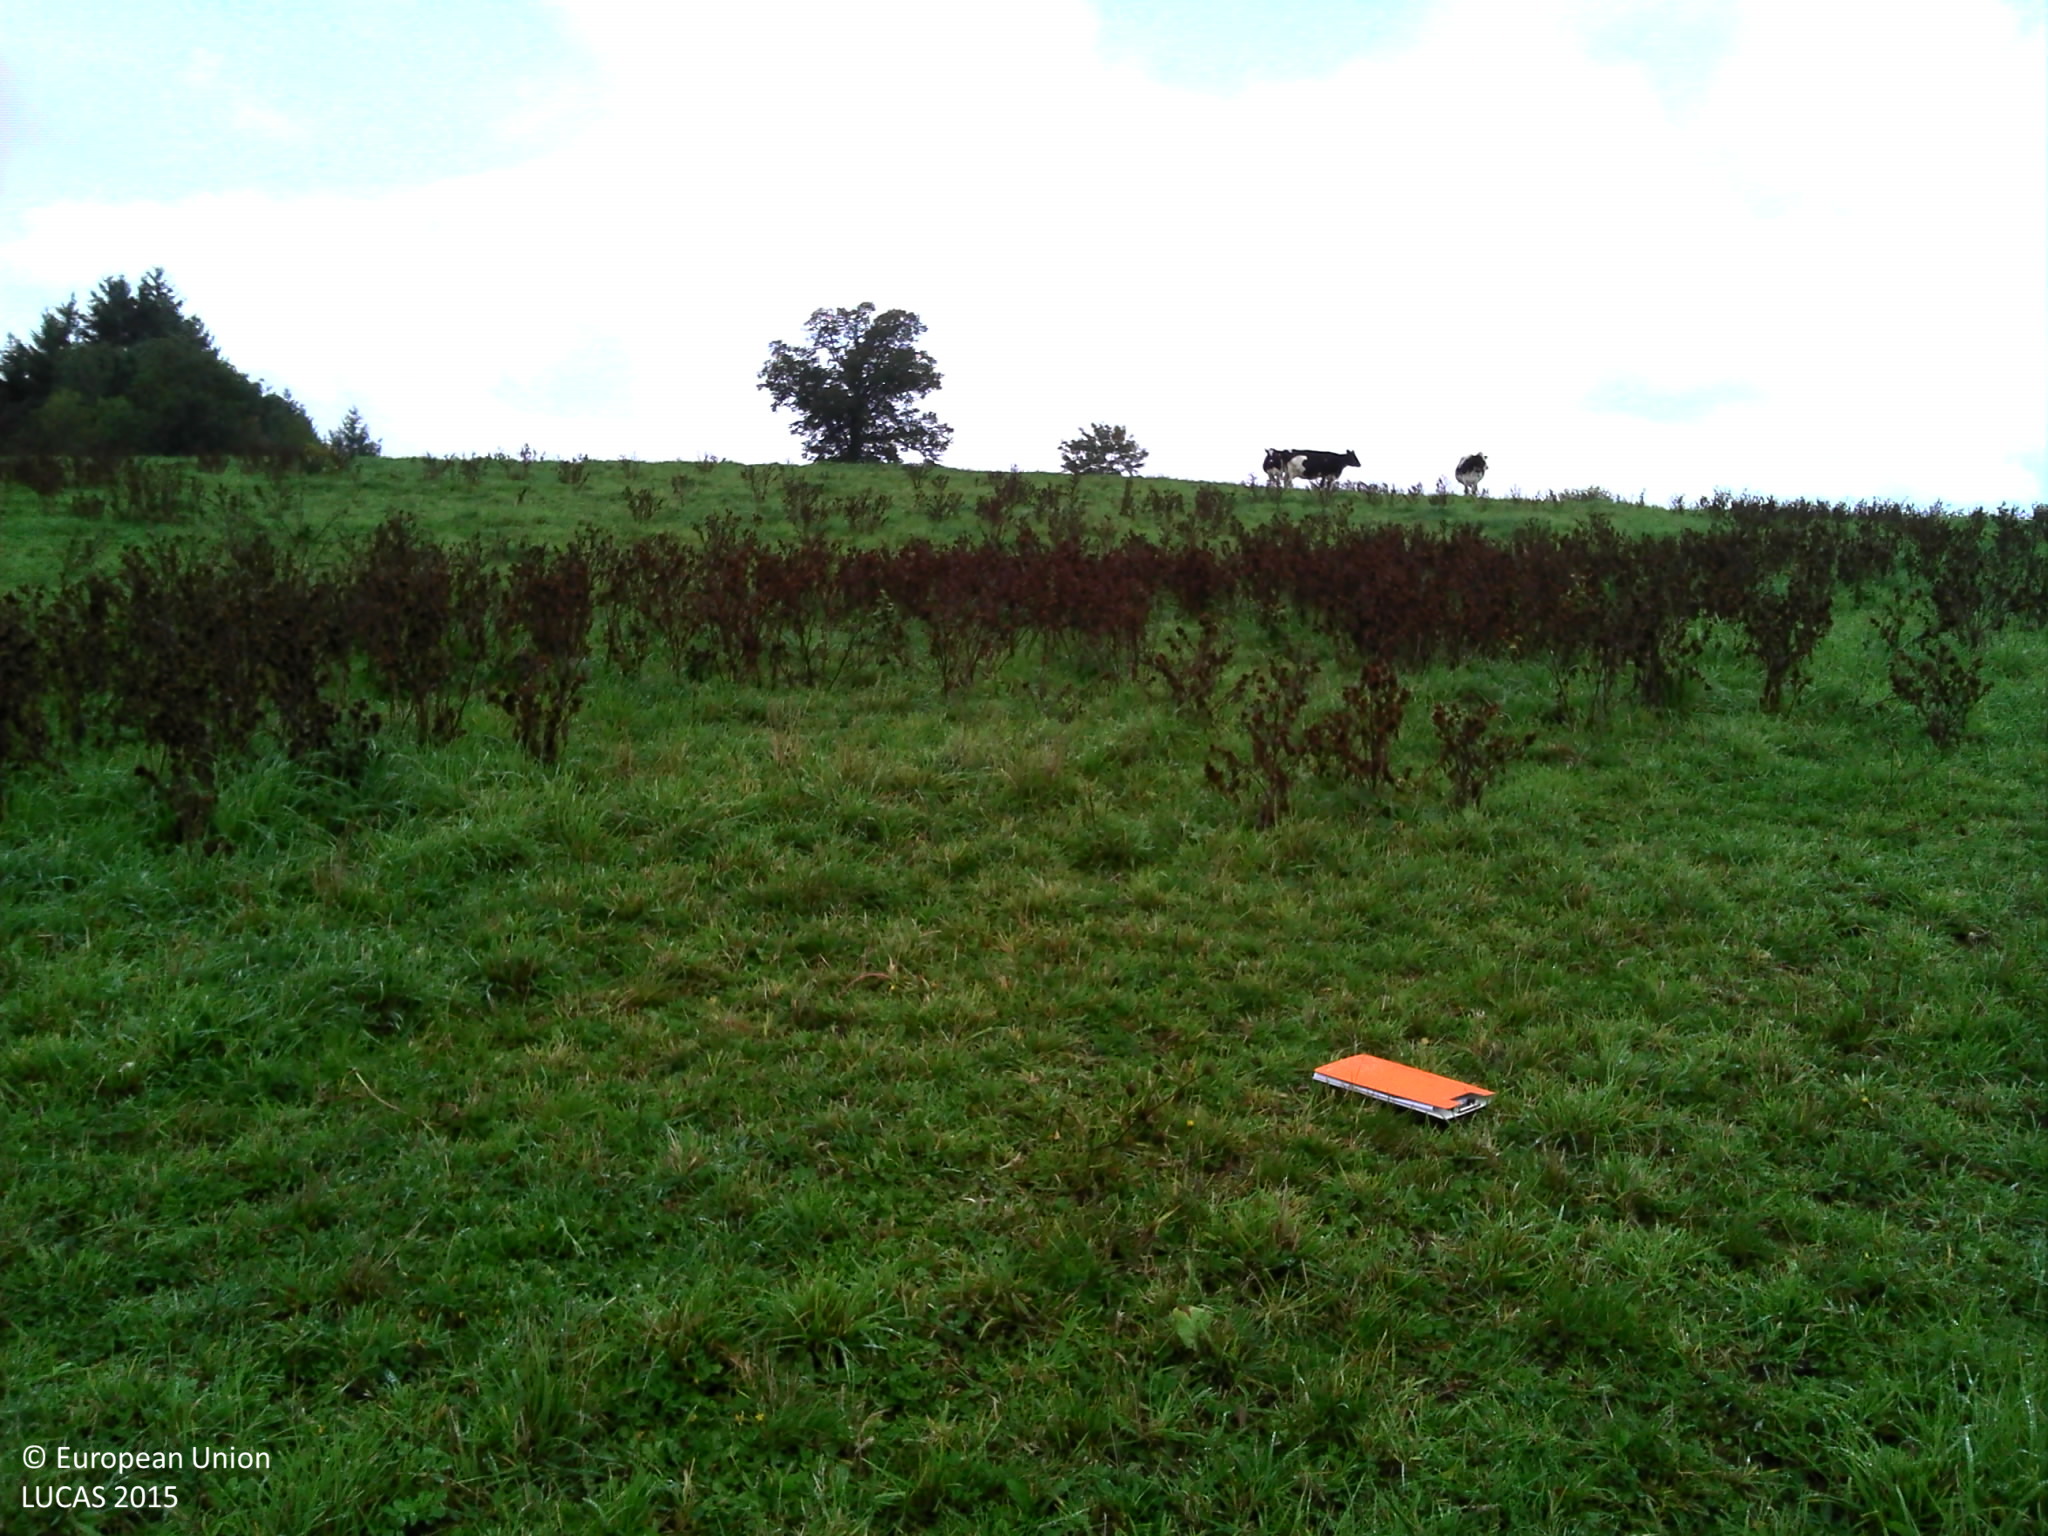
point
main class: Grassland
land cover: Grassland without tree/shrub cover
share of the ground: > 75 %
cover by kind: herbaceous plants 100 %
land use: Agriculture (excluding fallow land and kitchen gardens)
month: October
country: FR
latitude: 45.9859
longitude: 2.8595
